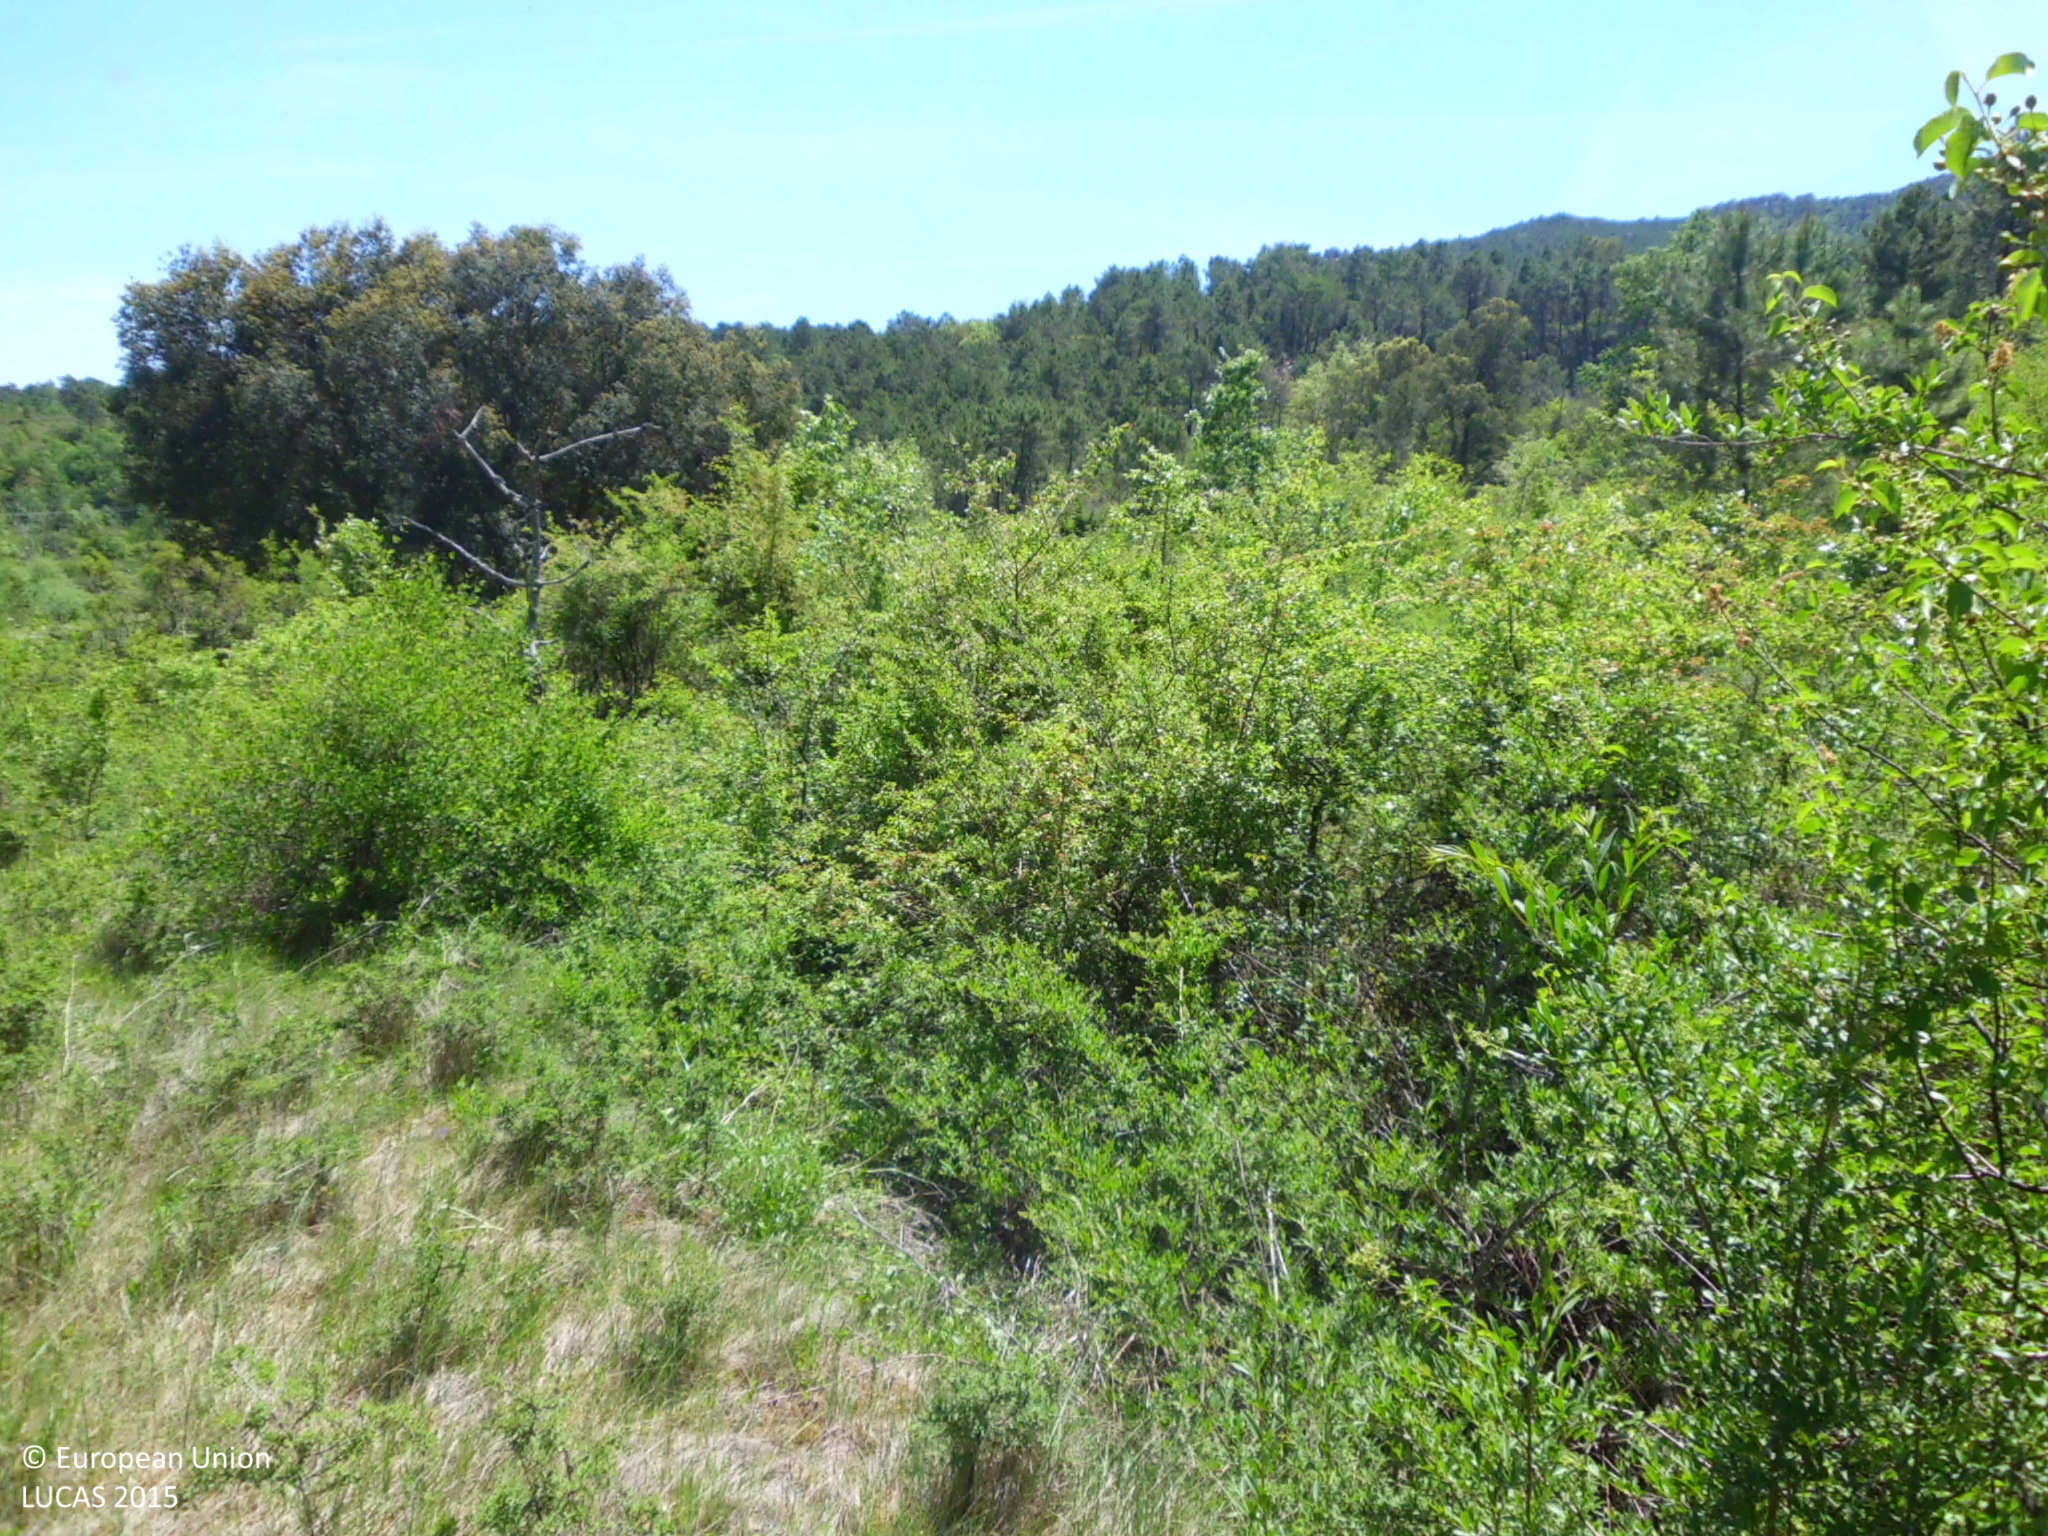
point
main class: Woodland
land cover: Pine dominated coniferous woodland
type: coniferous forest of the mediterranean region
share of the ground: > 75 %
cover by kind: coniferous forest trees 75 %, herbaceous plants 15 %, shrubs 10 %
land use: Semi-natural and natural areas not in use
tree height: > 5 m
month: May
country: ES
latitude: 42.7348
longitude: -3.4850
